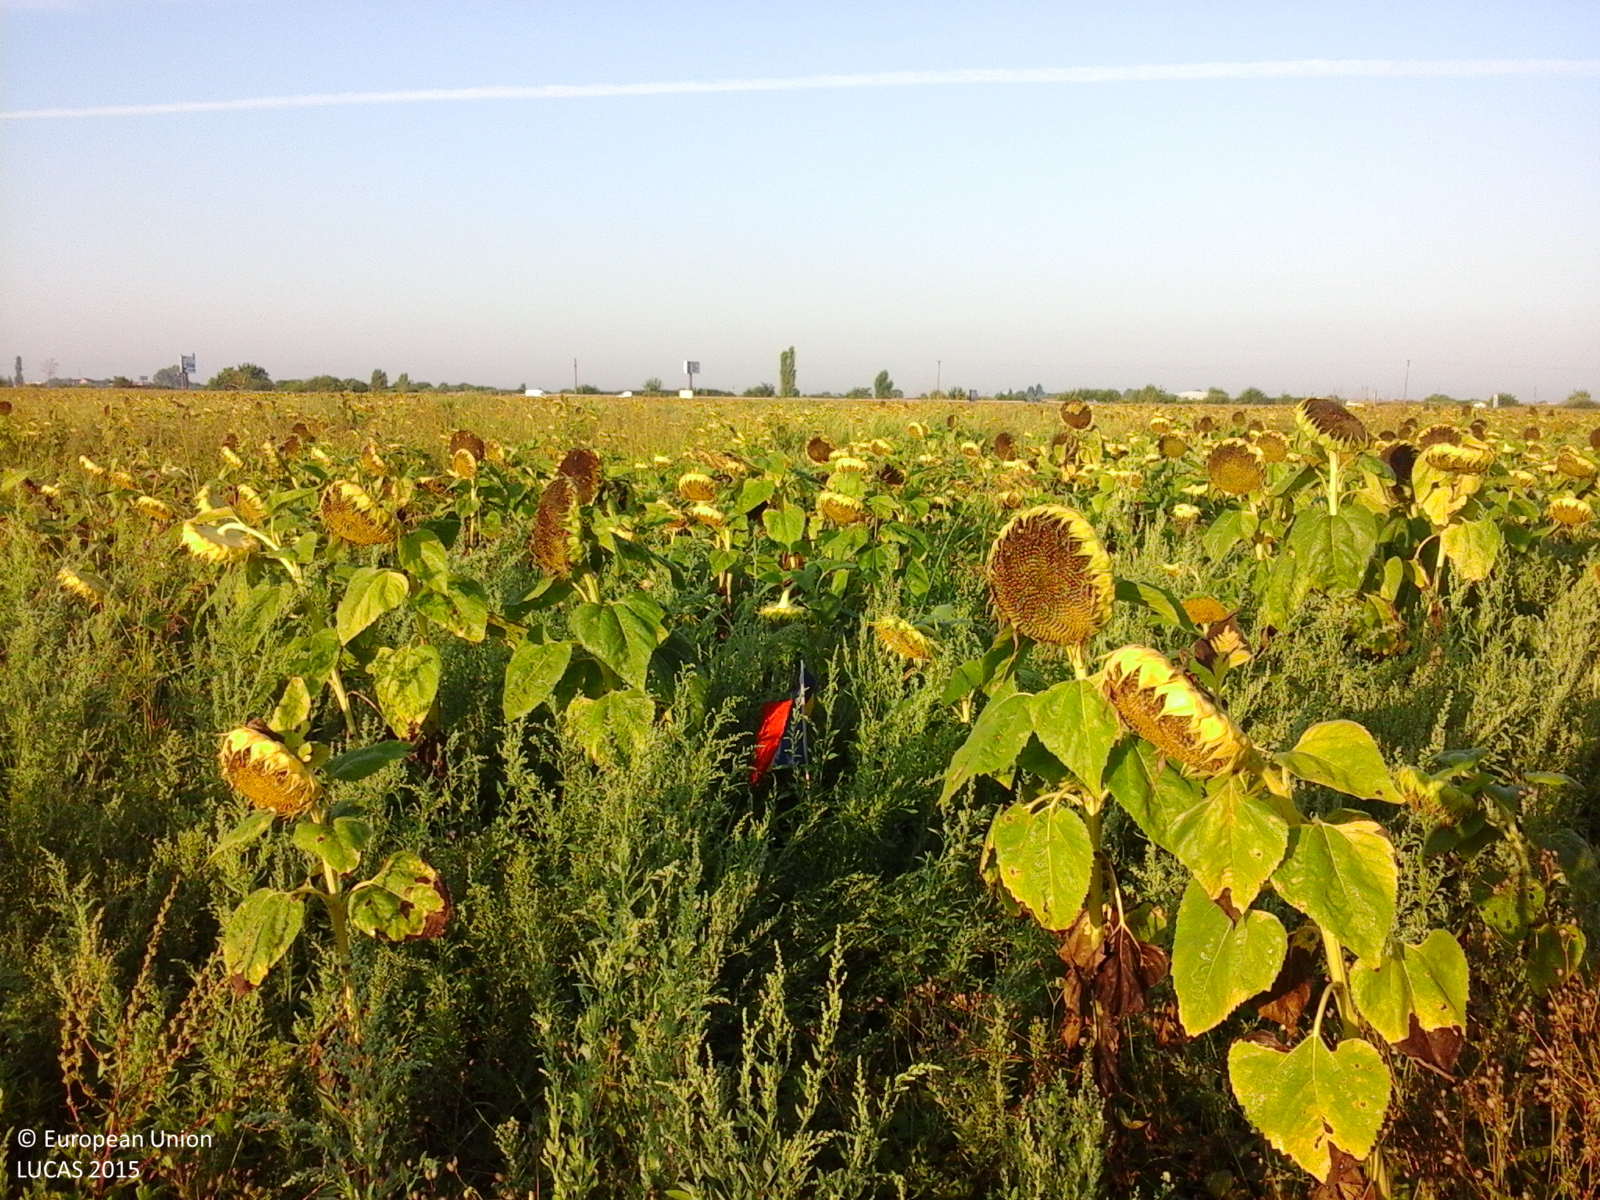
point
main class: Cropland
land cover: Sunflower
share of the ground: > 75 %
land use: Agriculture (excluding fallow land and kitchen gardens)
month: August
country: RO
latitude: 45.7963
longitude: 21.2105
